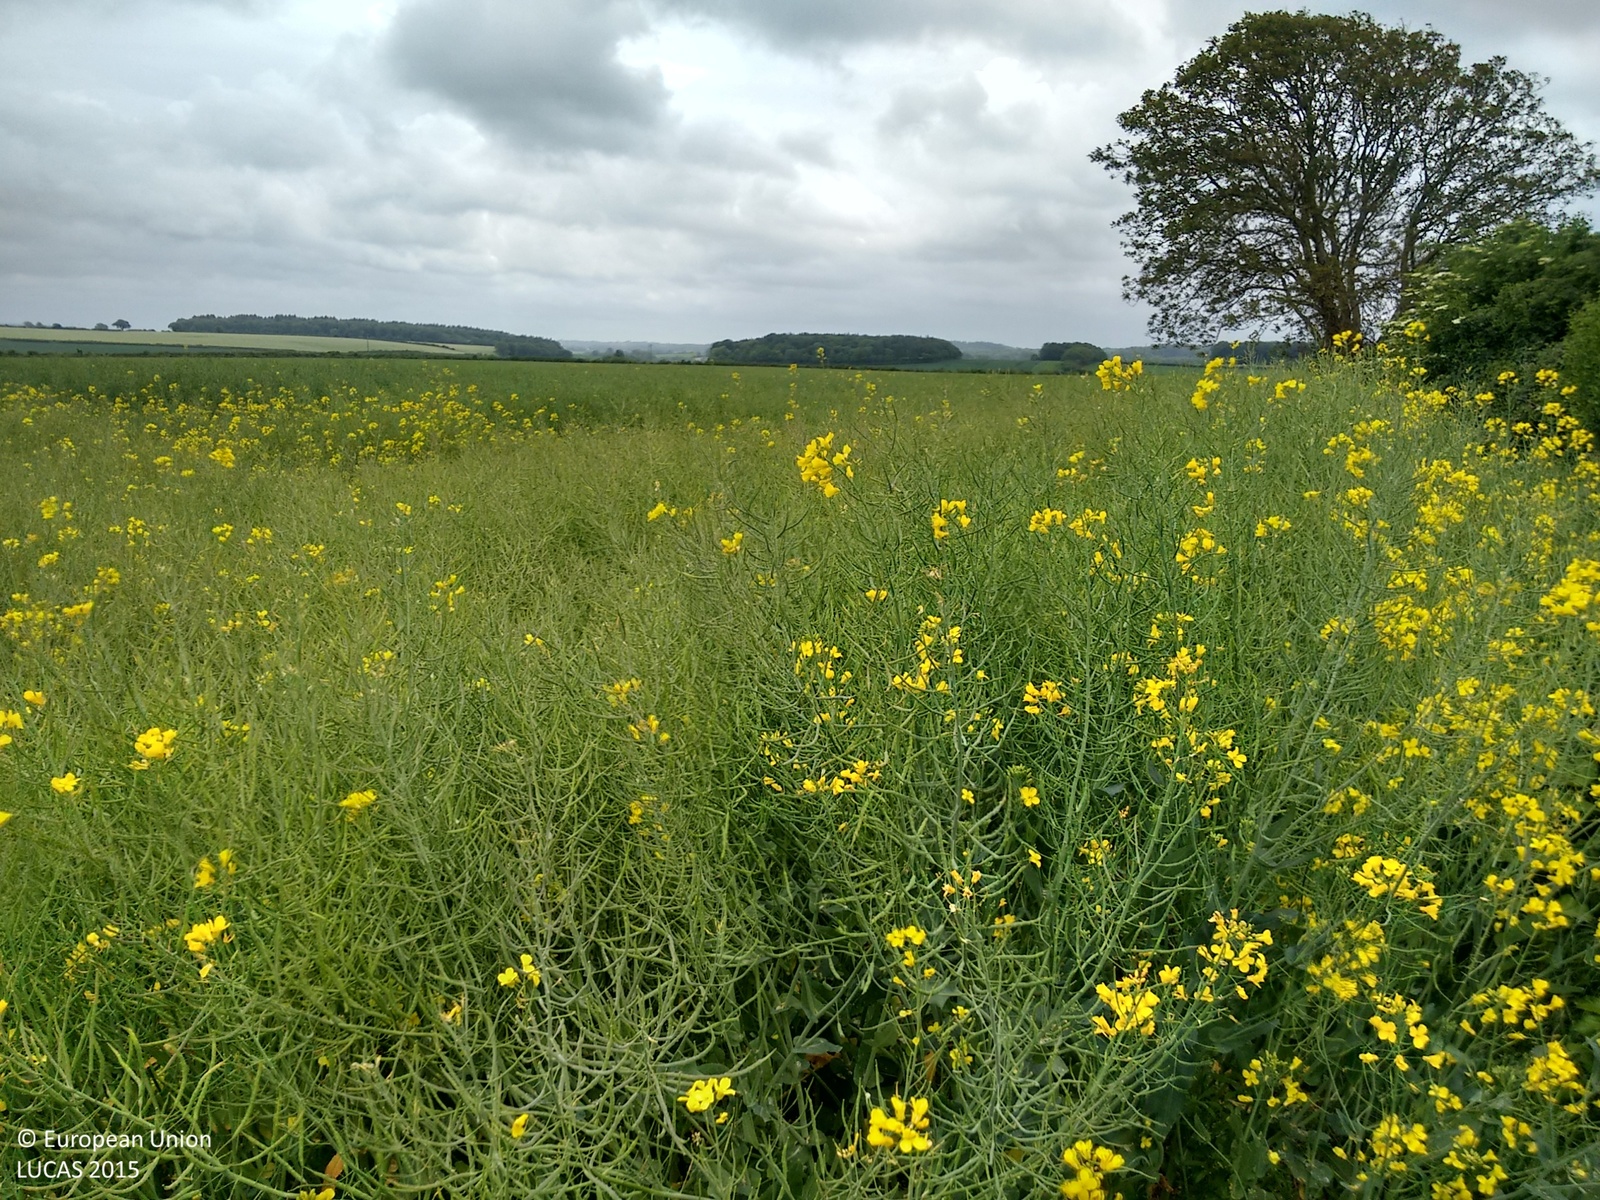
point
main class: Cropland
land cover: Rape and turnip rape
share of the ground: > 75 %
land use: Agriculture (excluding fallow land and kitchen gardens)
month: May
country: GB
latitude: 50.8062
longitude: -2.1364
